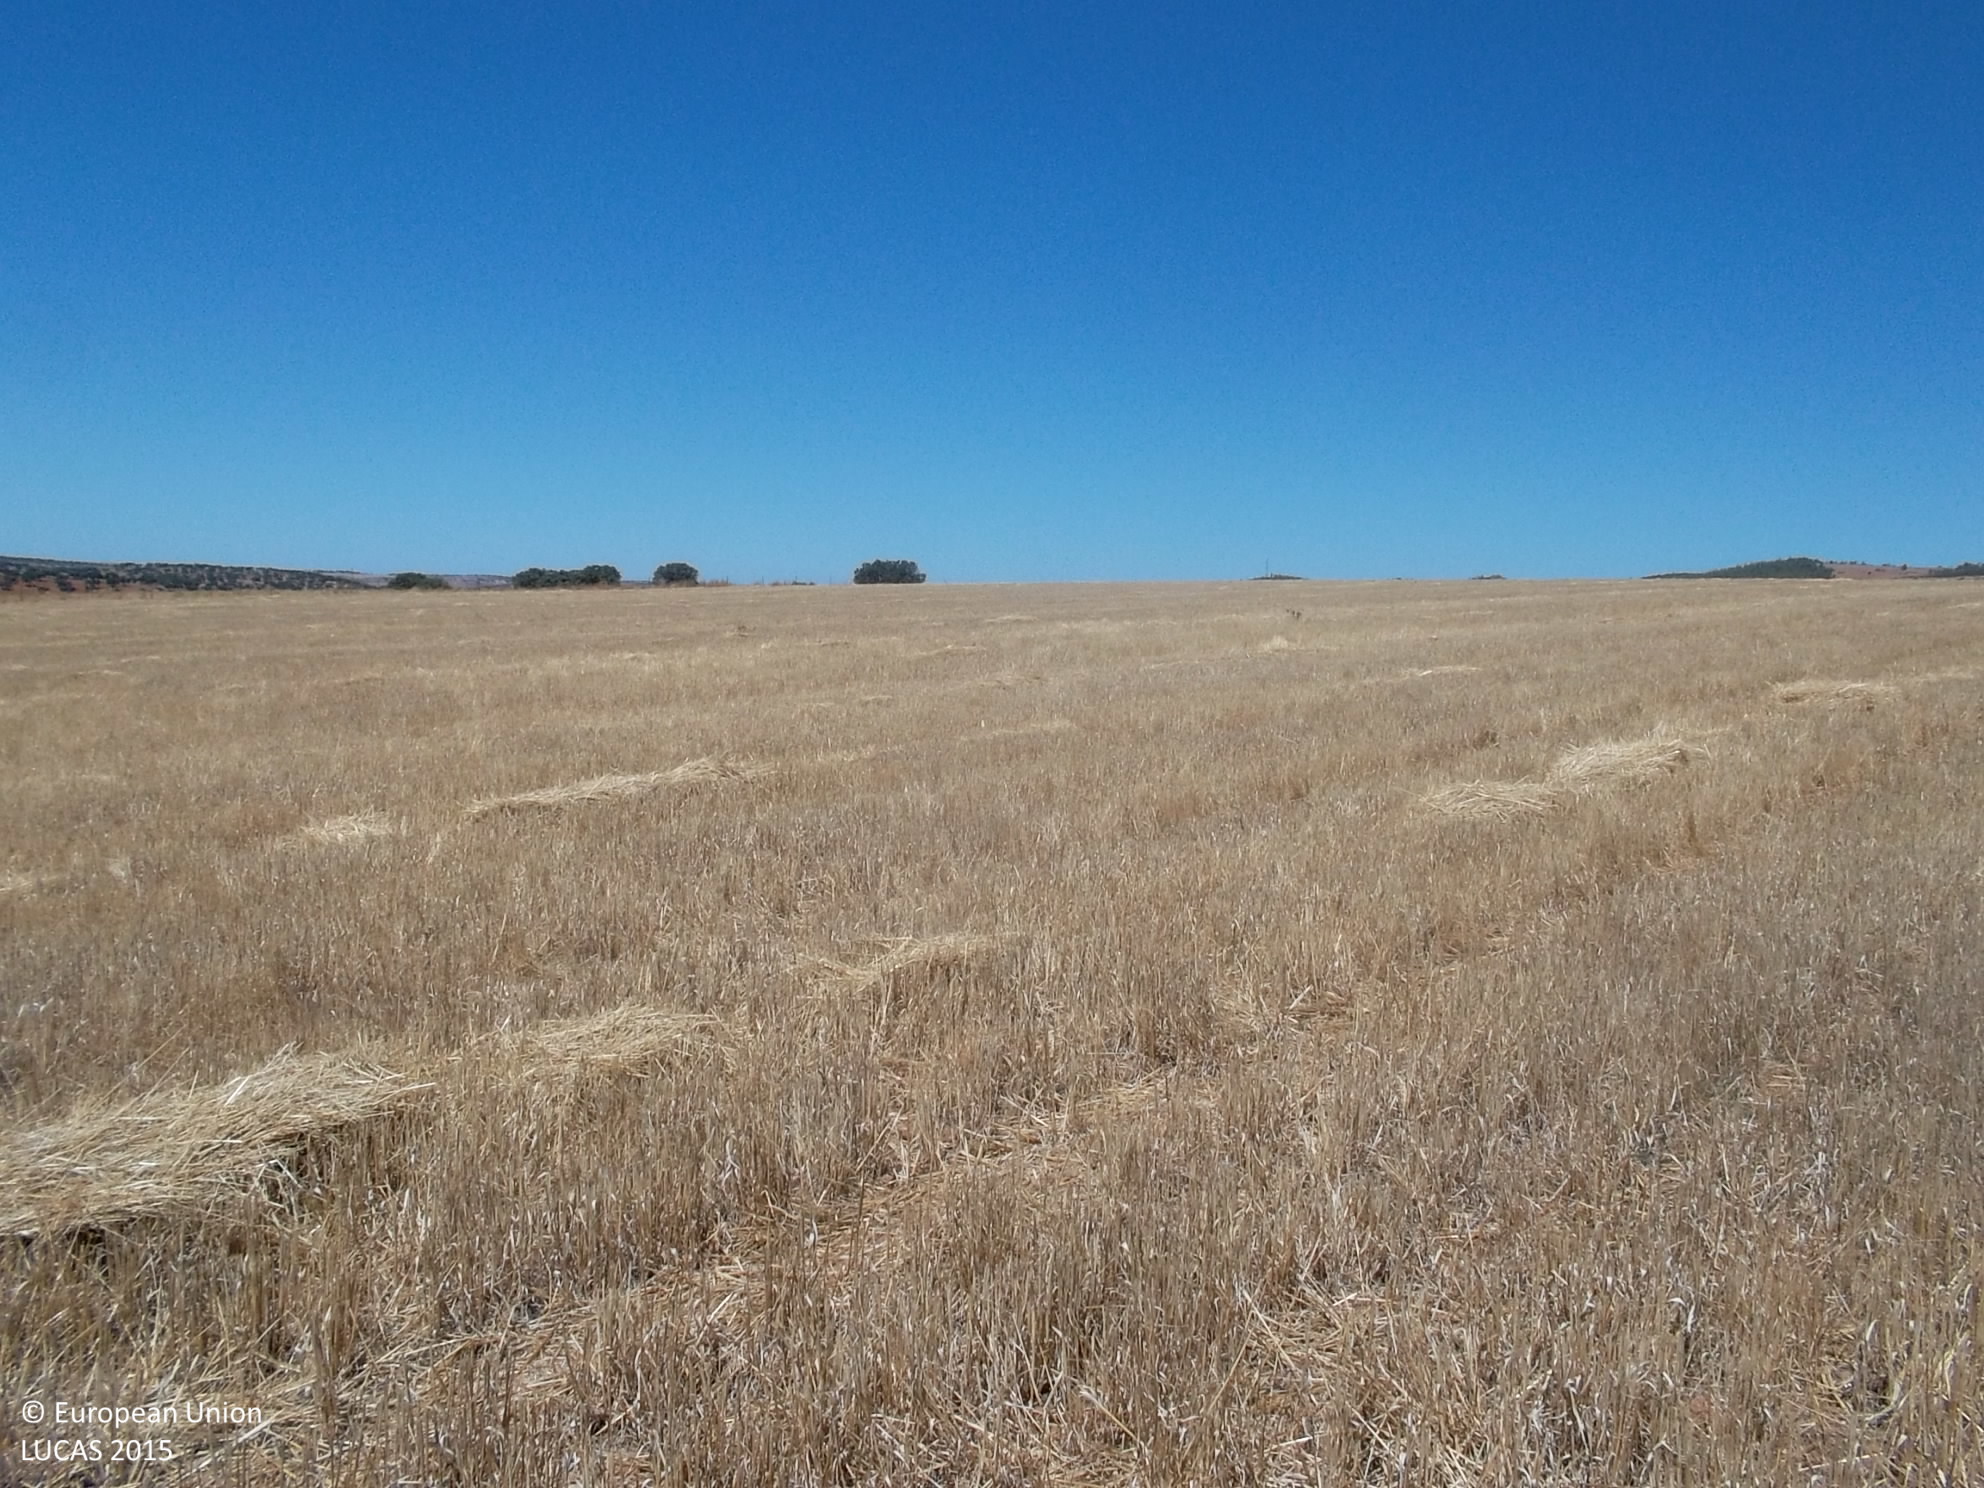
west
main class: Cropland
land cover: Oats
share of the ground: < 10 %
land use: Agriculture (excluding fallow land and kitchen gardens)
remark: Harvested field
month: July
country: ES
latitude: 38.4061
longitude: -5.8077
